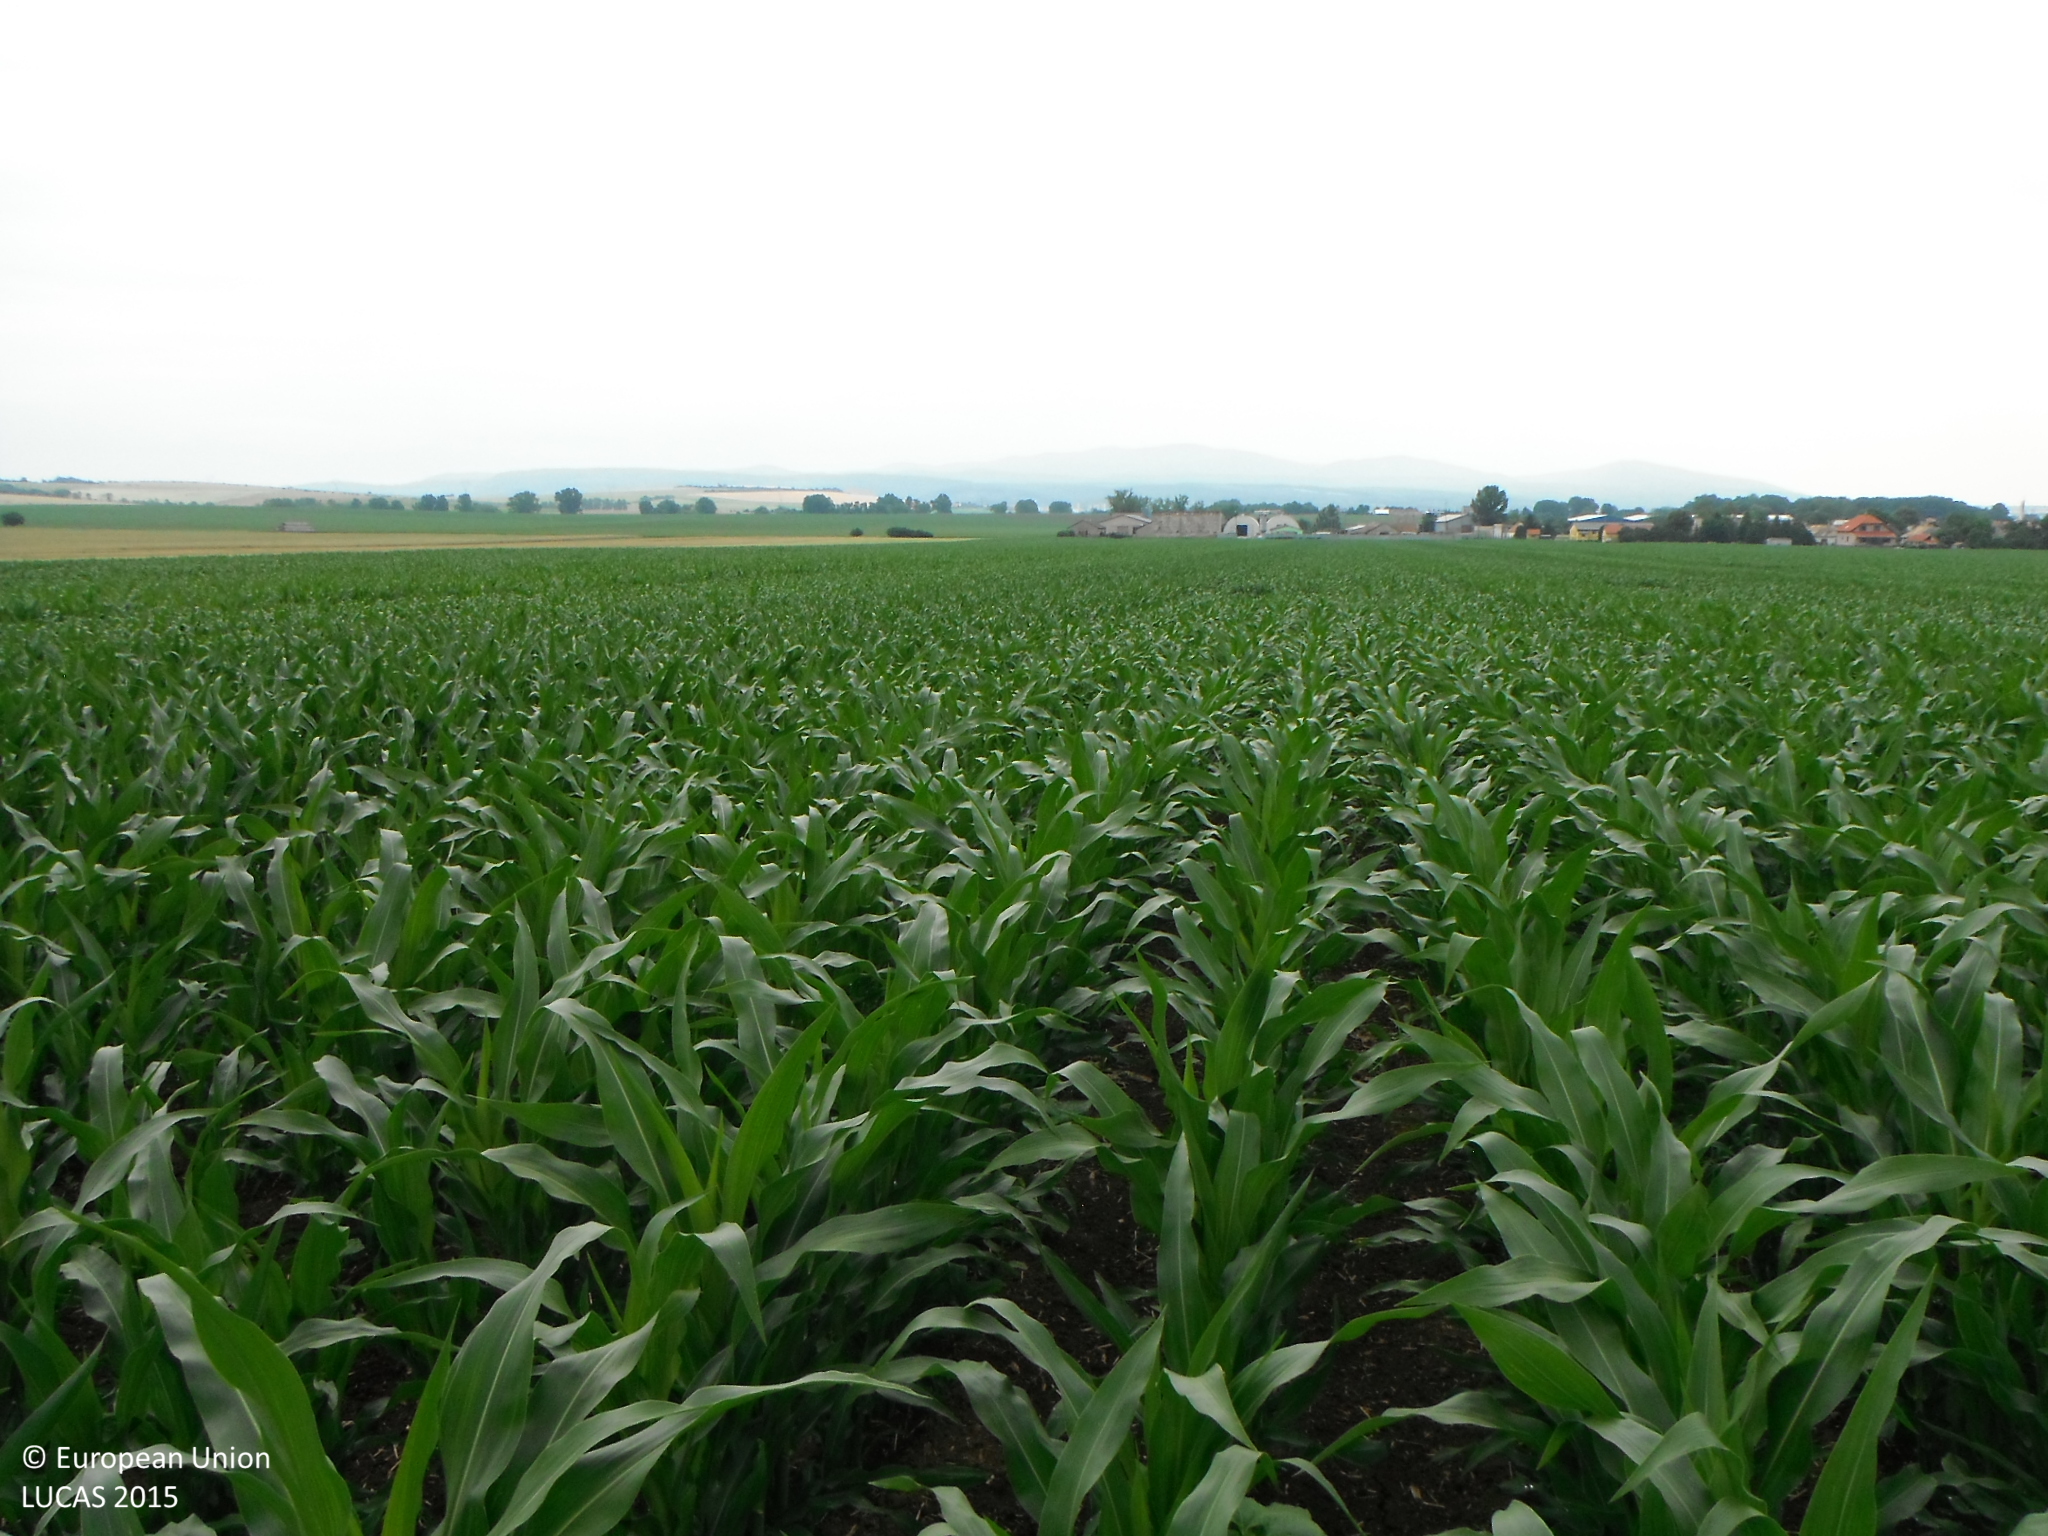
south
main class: Cropland
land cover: Maize
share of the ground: > 75 %
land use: Agriculture (excluding fallow land and kitchen gardens)
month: June
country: SK
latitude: 48.1123
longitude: 18.9512
